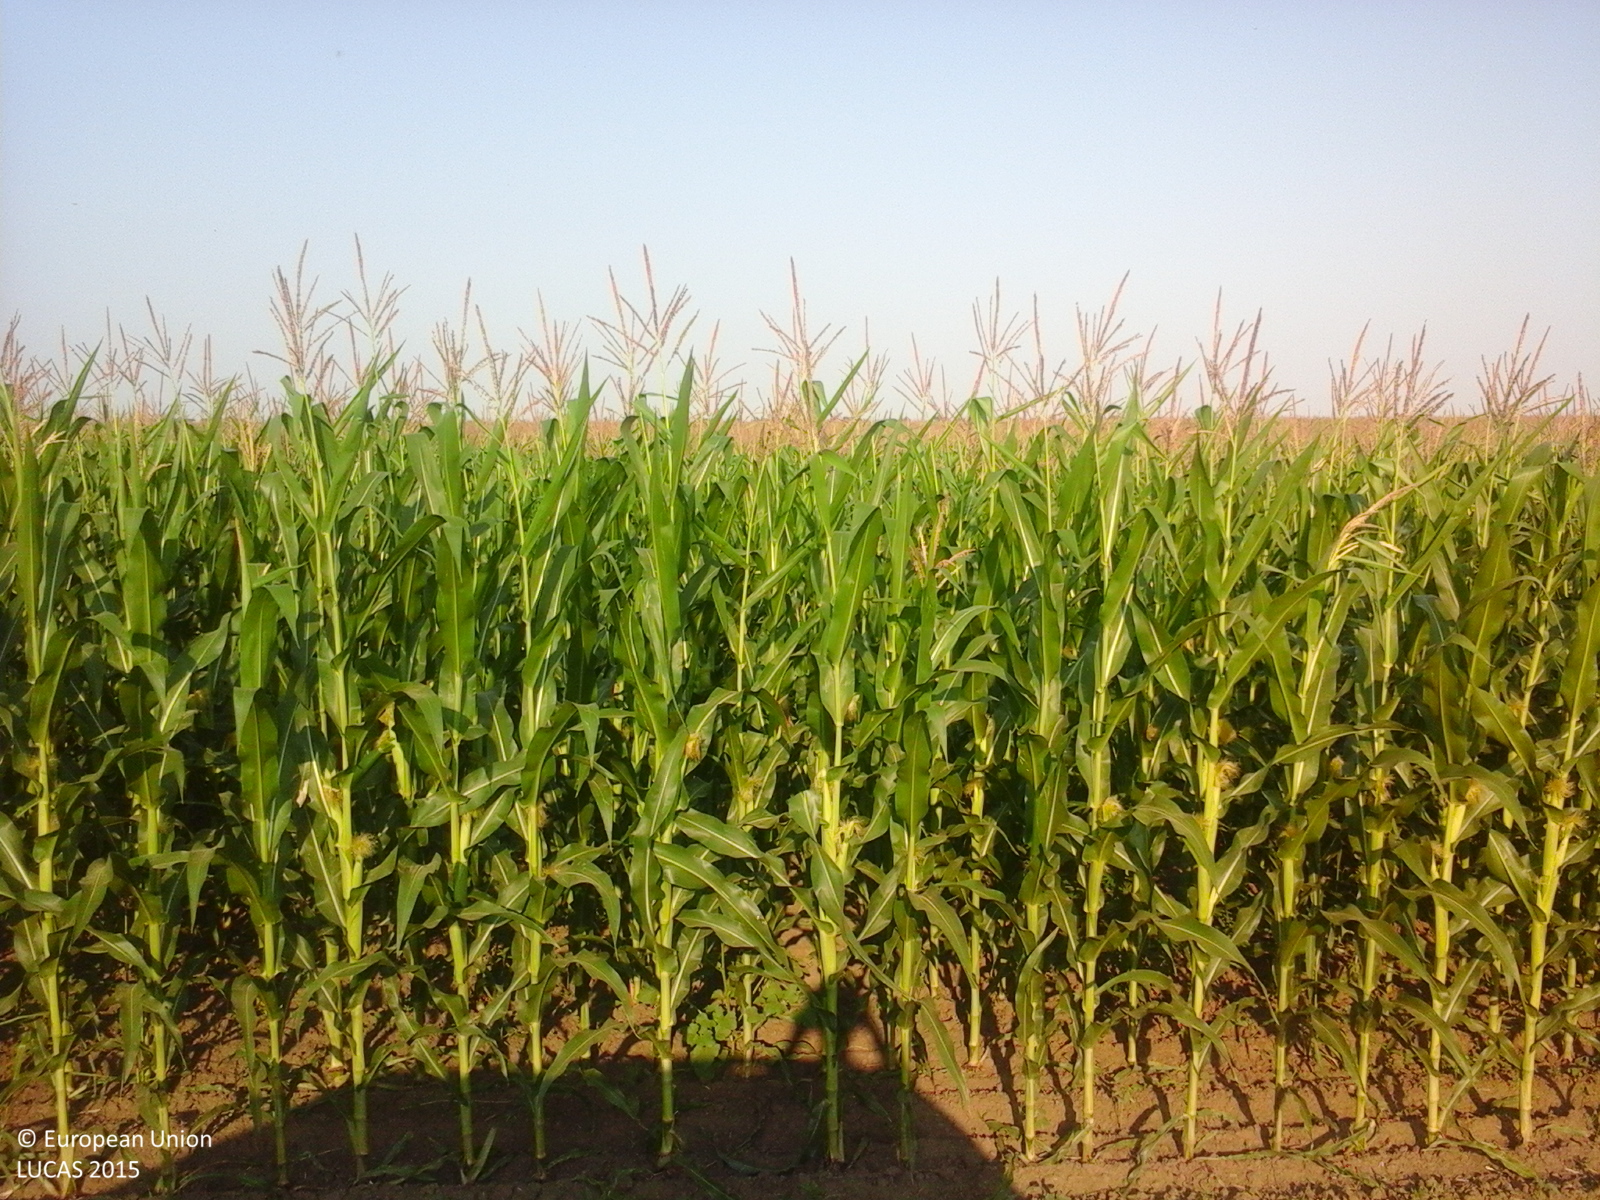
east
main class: Cropland
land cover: Maize
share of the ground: > 75 %
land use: Agriculture (excluding fallow land and kitchen gardens)
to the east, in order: Maize; Tracks; Maize
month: July
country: RO
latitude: 44.6556
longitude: 27.2760
